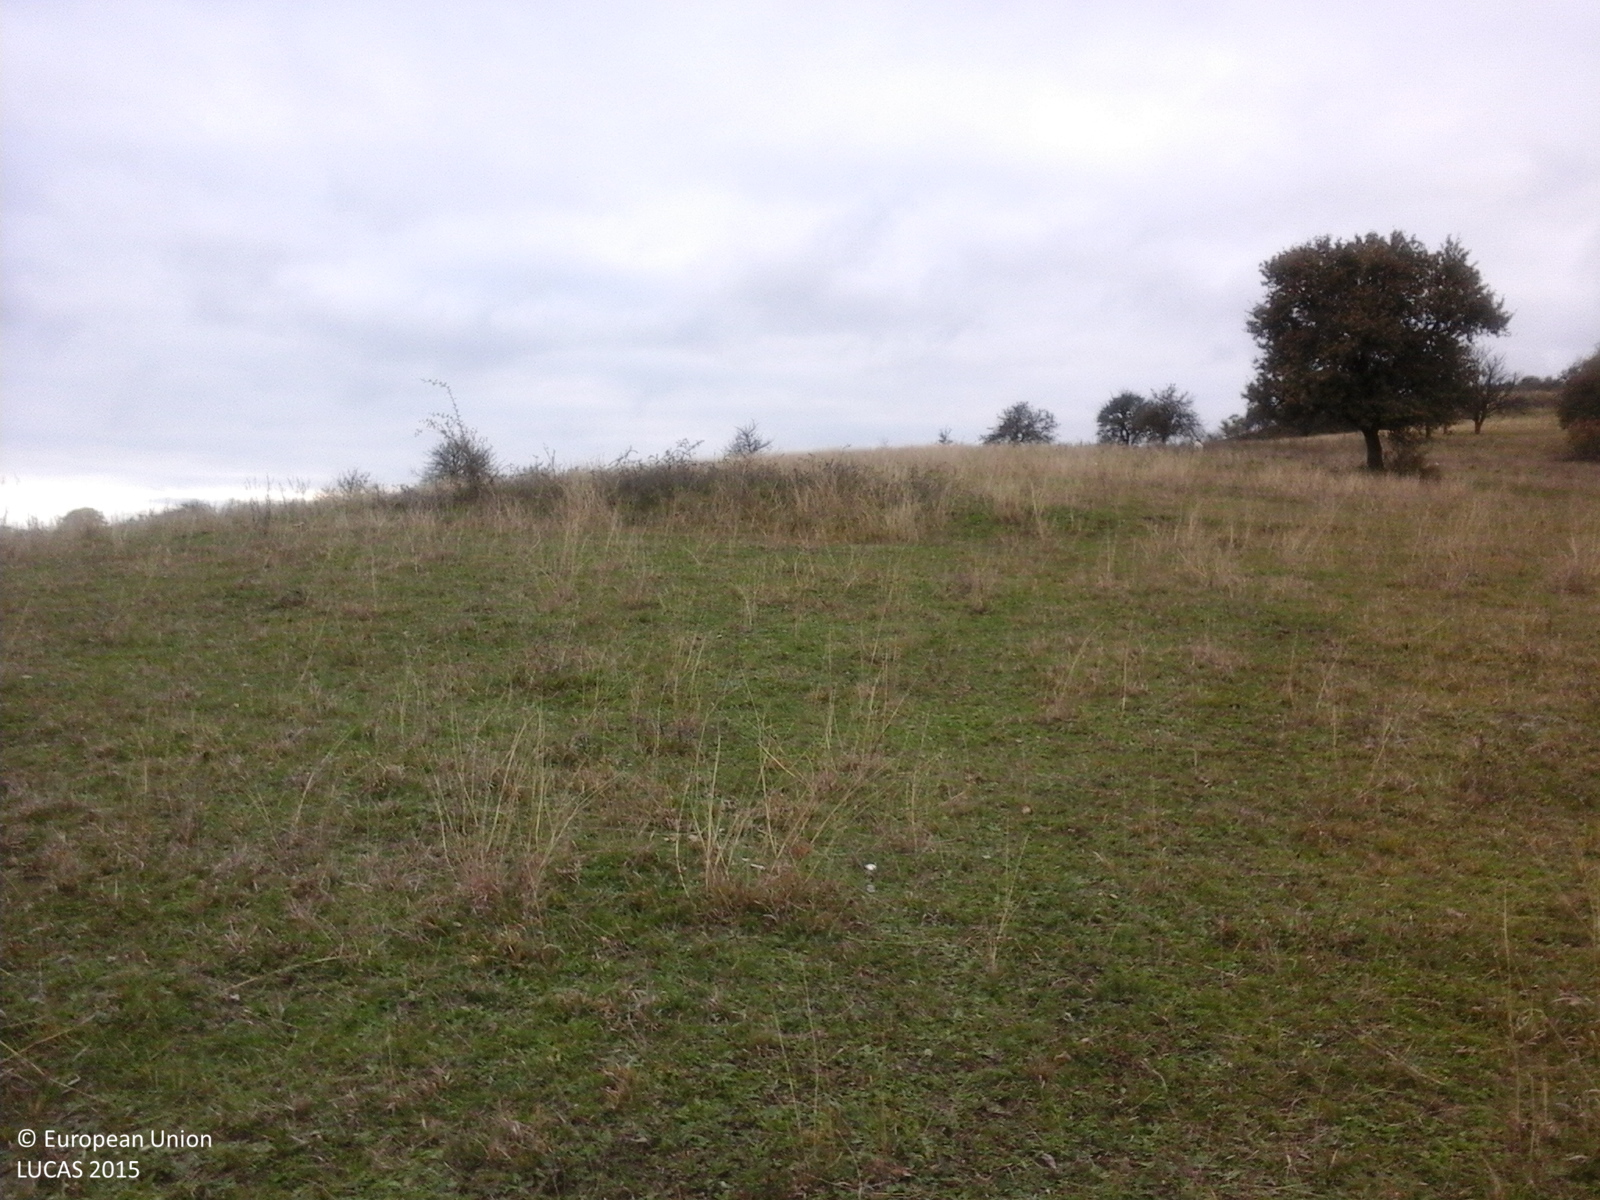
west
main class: Grassland
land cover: Grassland with sparse tree/shrub cover
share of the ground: > 75 %
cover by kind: herbaceous plants 95 %, broadleaved forest trees 5 %
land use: Agriculture (excluding fallow land and kitchen gardens)
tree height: > 5 m
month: October
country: RO
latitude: 45.9501
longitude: 24.8355
